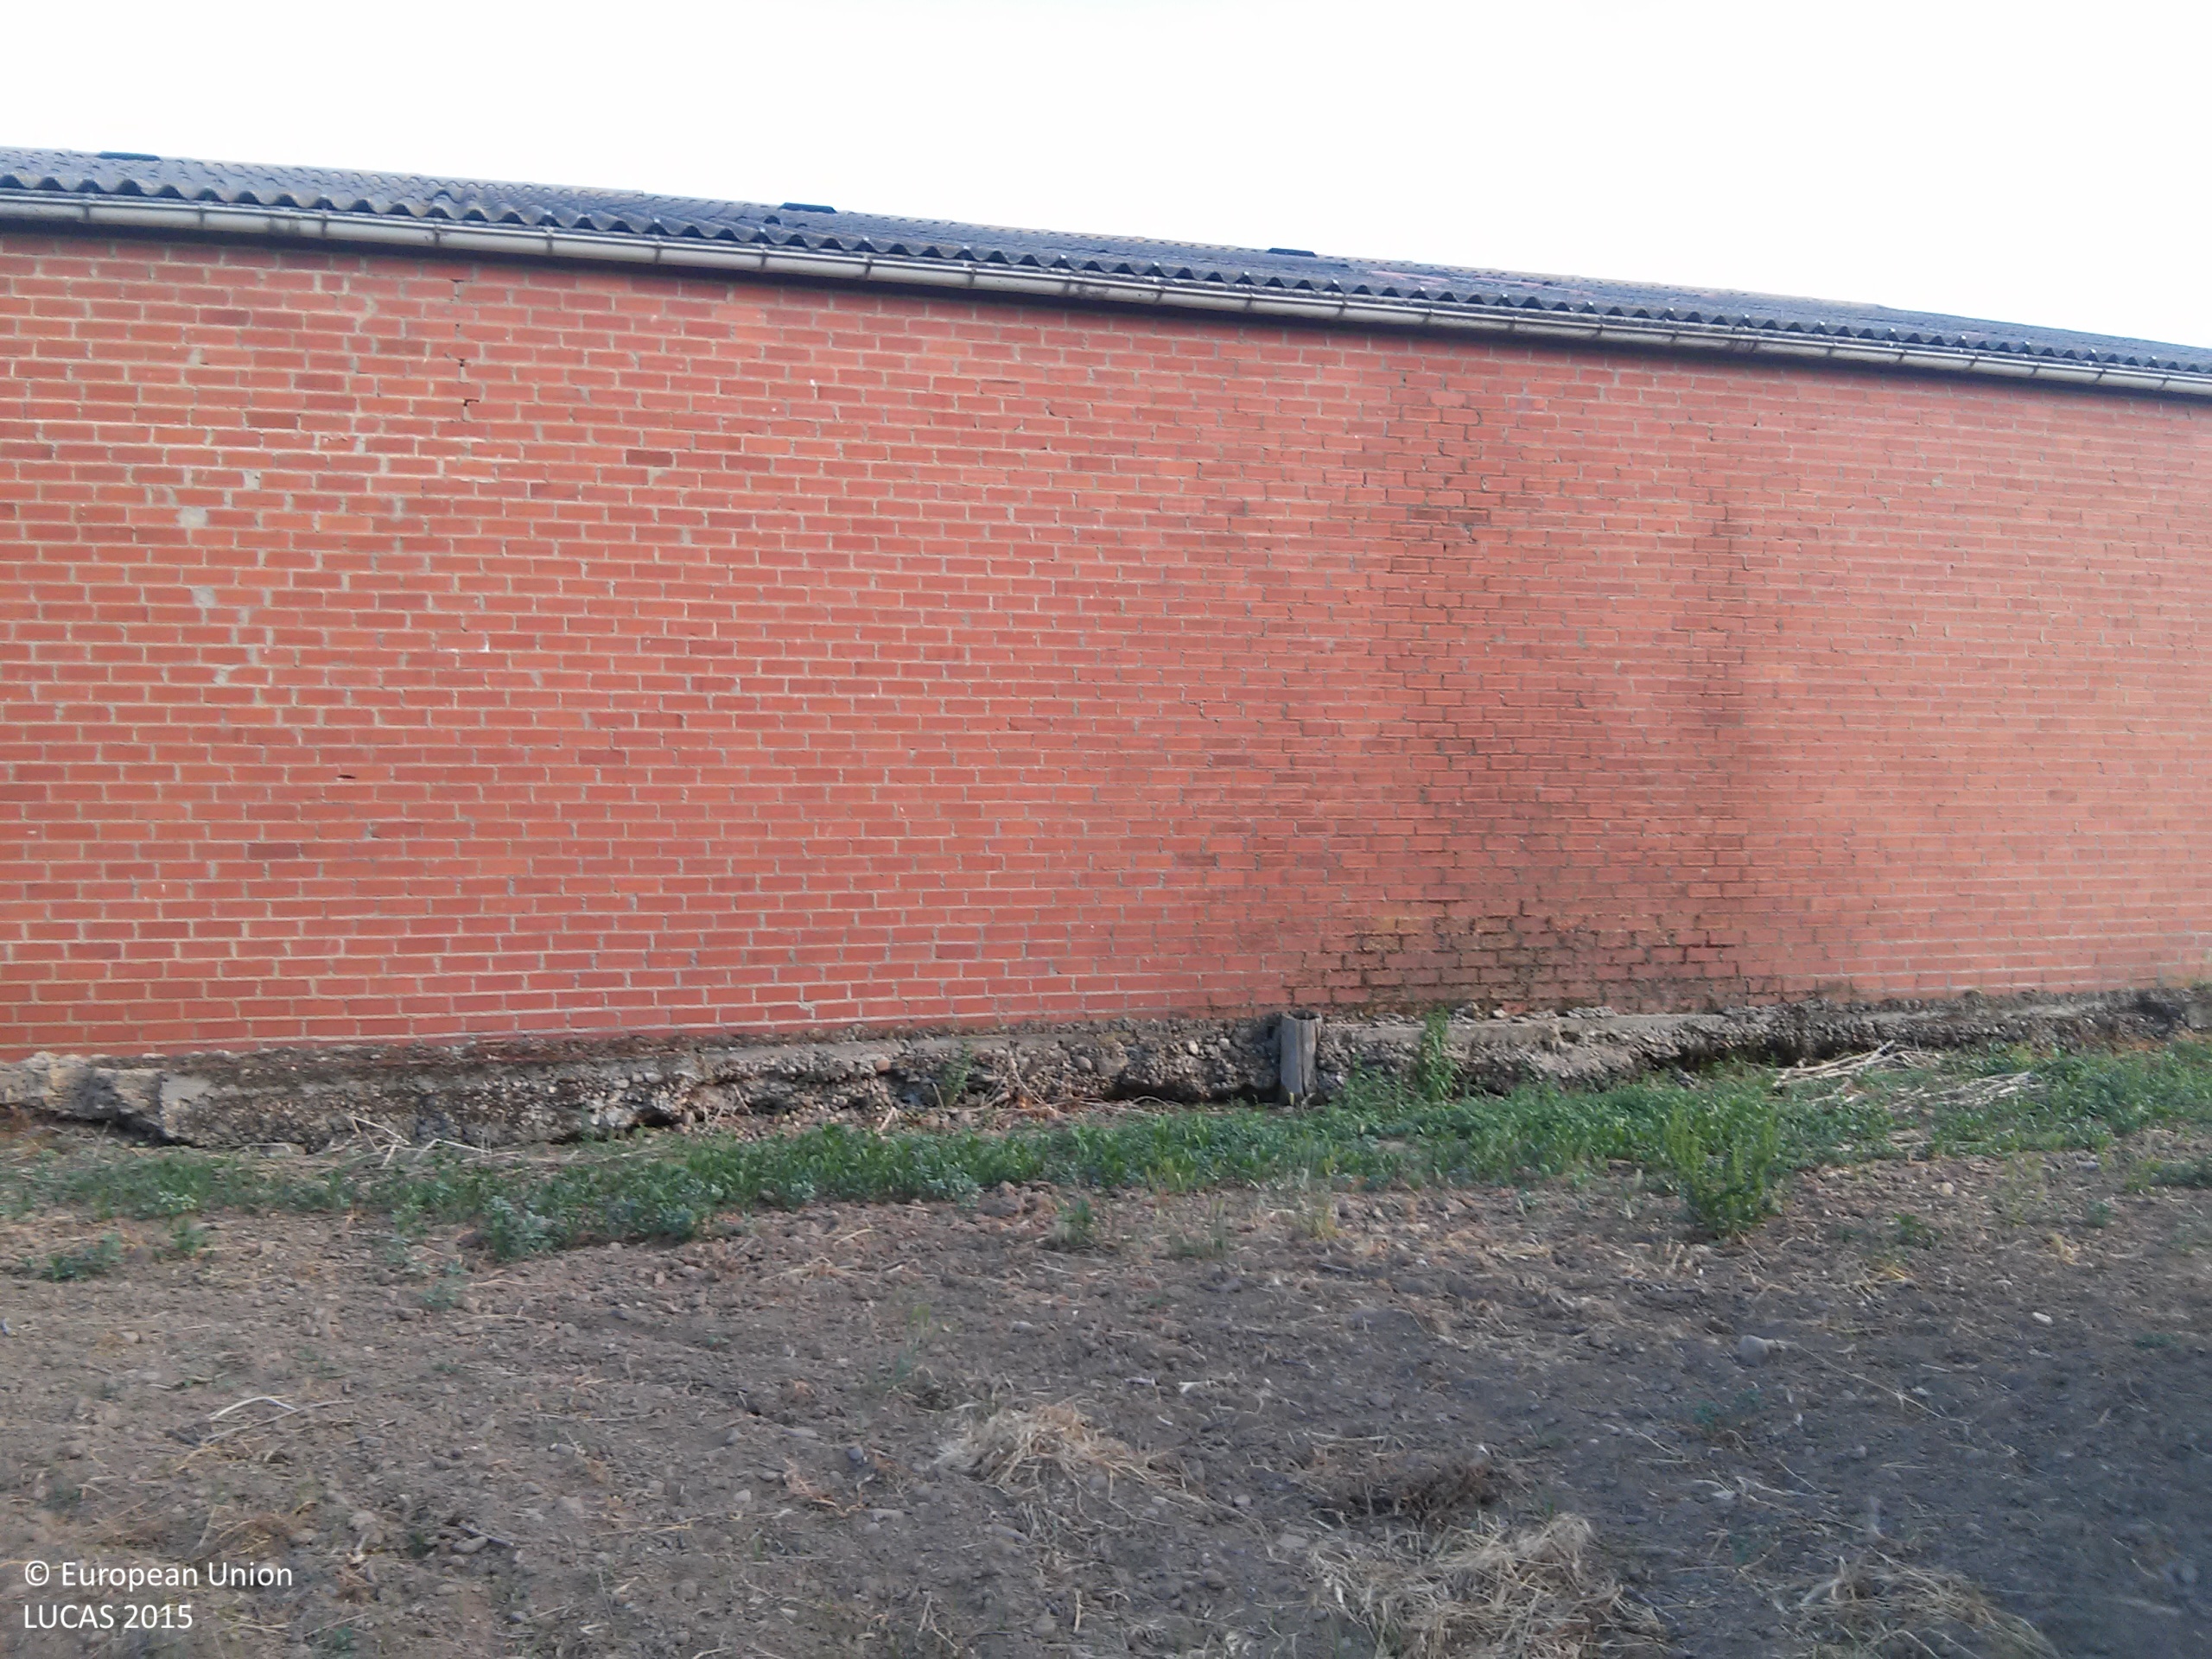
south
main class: Cropland
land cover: Nuts trees
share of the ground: < 10 %
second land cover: Other bare soil
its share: > 75 %
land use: Agriculture (excluding fallow land and kitchen gardens)
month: June
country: ES
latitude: 42.4365
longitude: -5.5452
